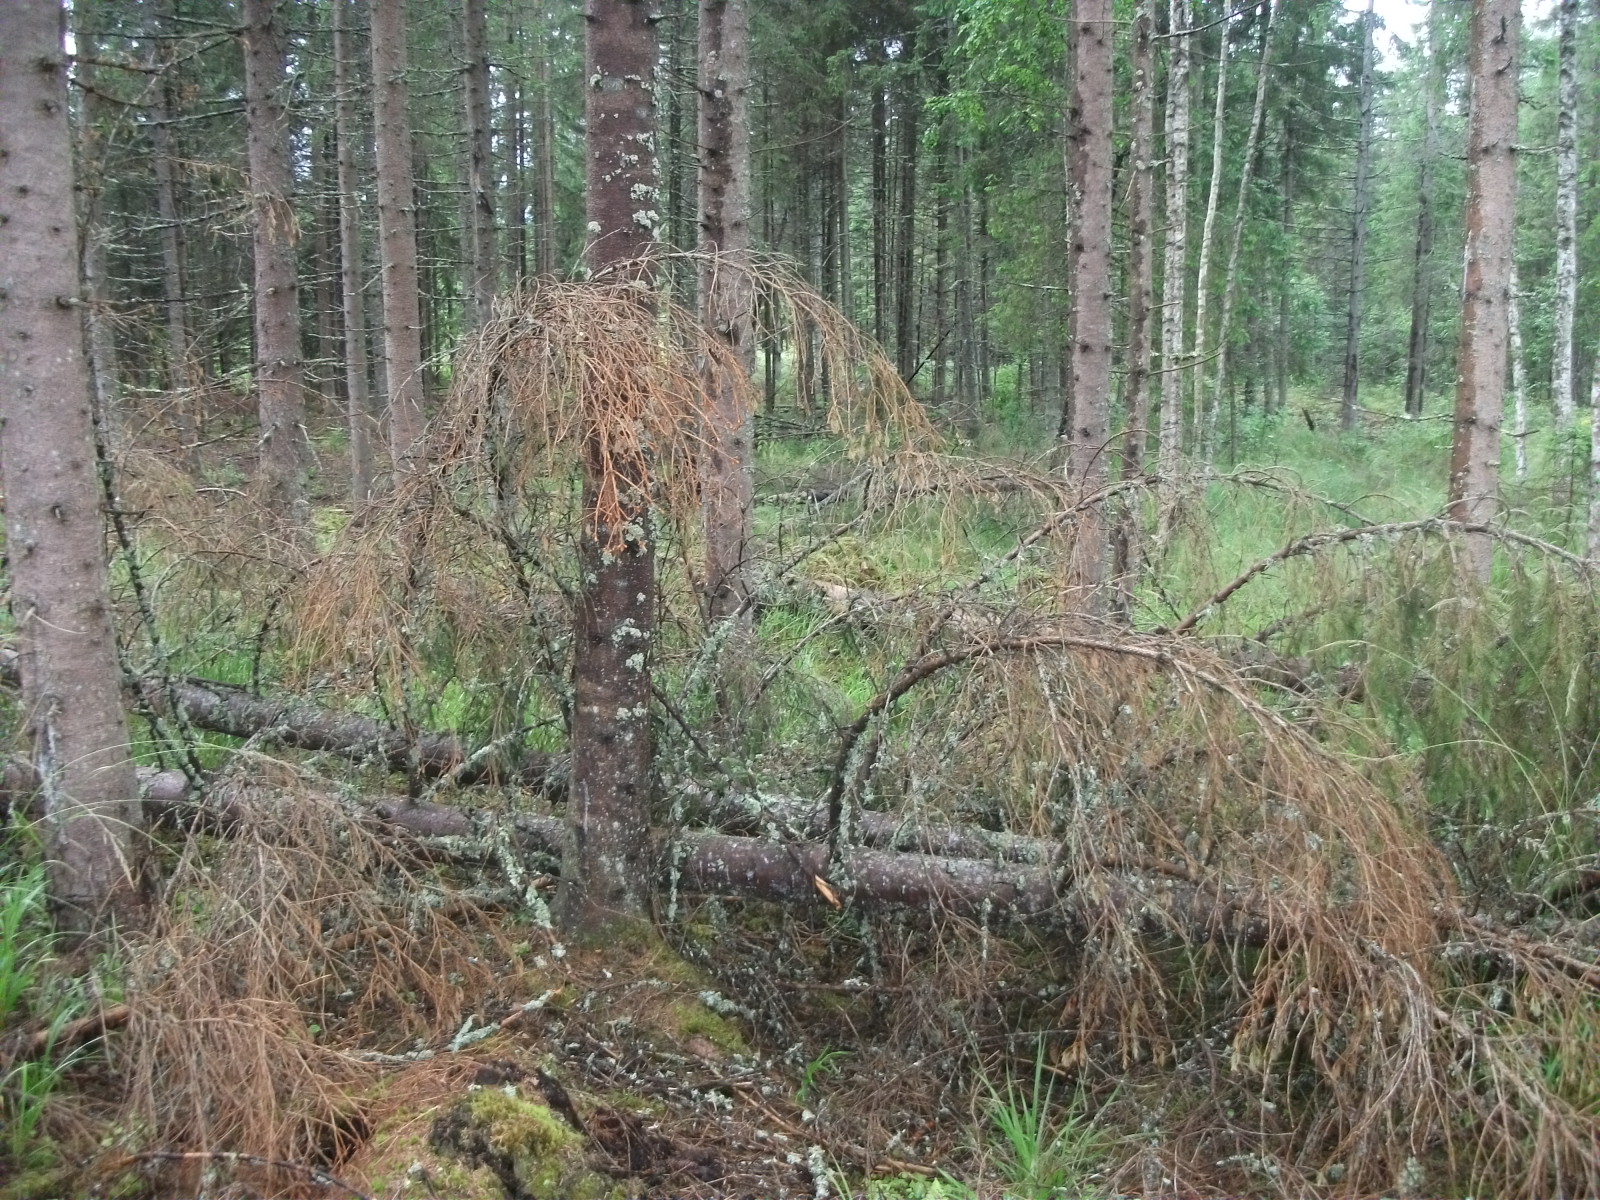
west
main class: Woodland
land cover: Spruce dominated coniferous woodland
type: hemiboreal forest and nemoral coniferous forest and mixed broadleaved-coniferous forest
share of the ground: 50 - 75 %
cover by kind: coniferous forest trees 60 %, herbaceous plants 15 %, lichens and mosses 15 %, unconsolidated bare surface 5 %
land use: Forestry
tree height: > 5 m
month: July
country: LV
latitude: 56.9729
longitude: 25.8711
